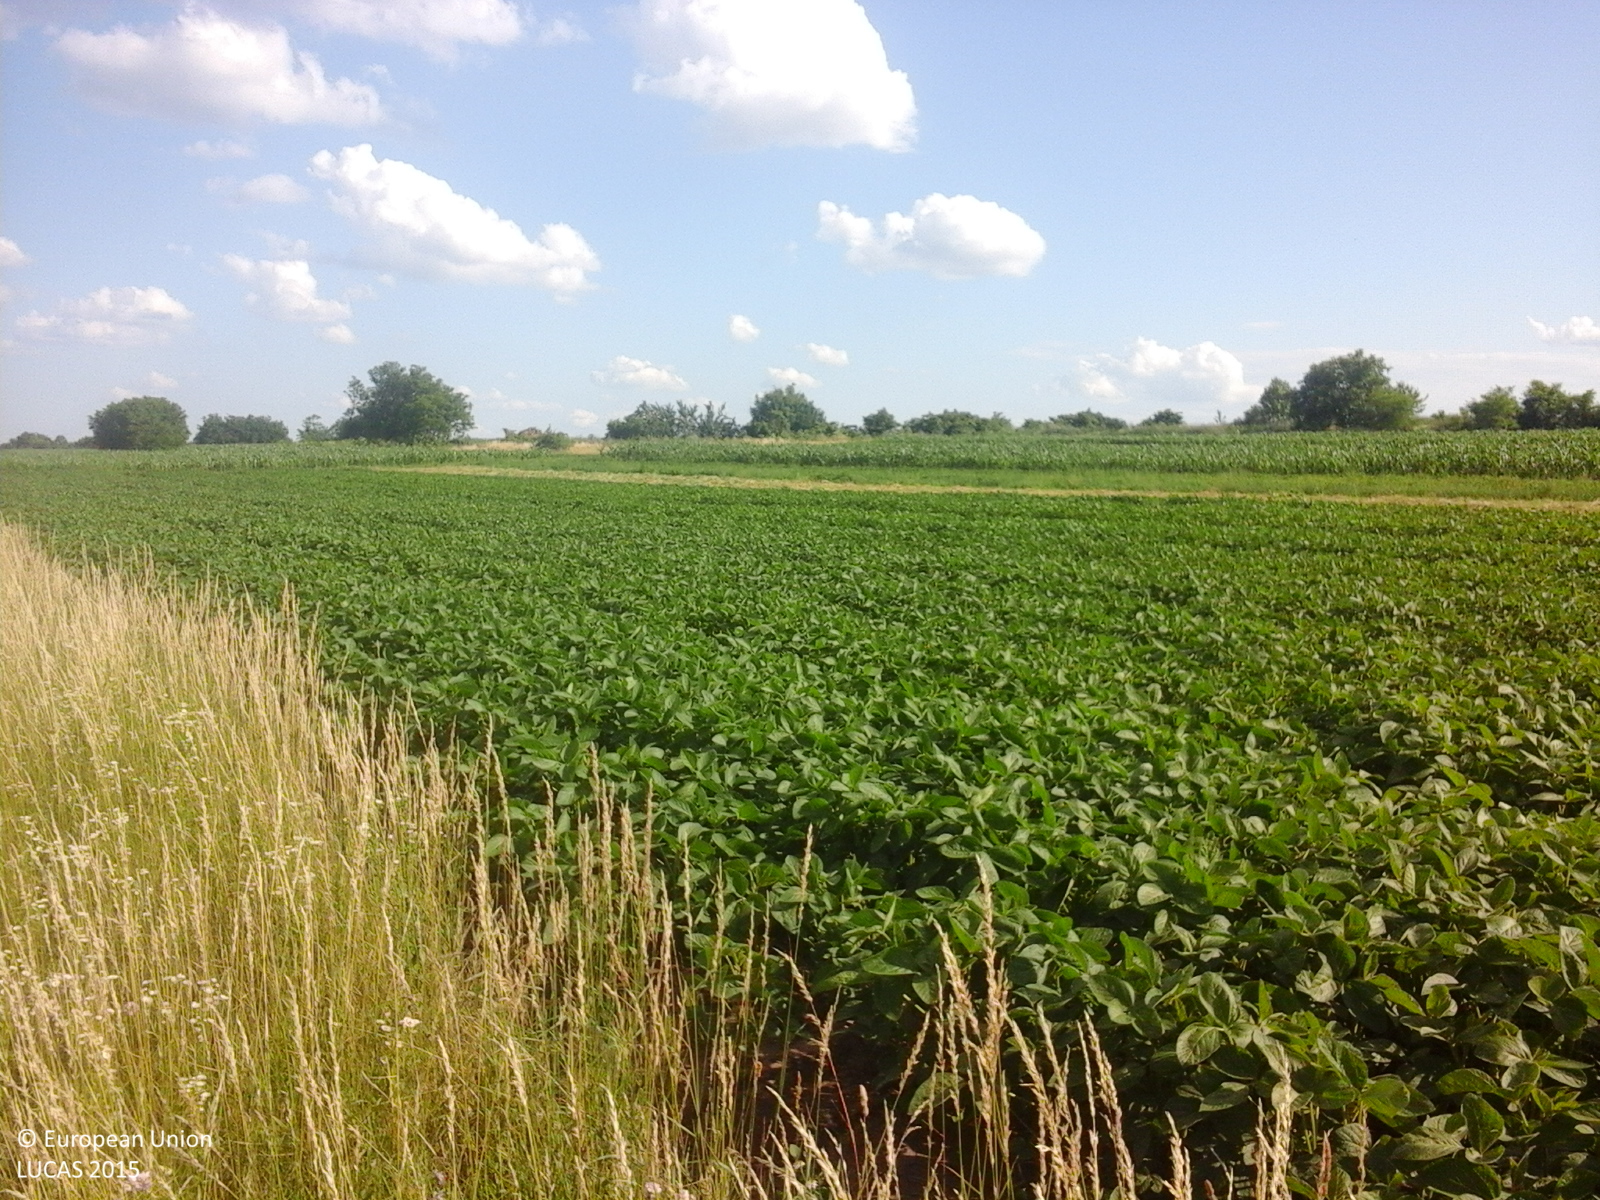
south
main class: Grassland
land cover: Grassland without tree/shrub cover
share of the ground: > 75 %
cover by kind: herbaceous plants 100 %
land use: Agriculture (excluding fallow land and kitchen gardens)
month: June
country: RO
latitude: 48.2418
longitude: 26.7021
